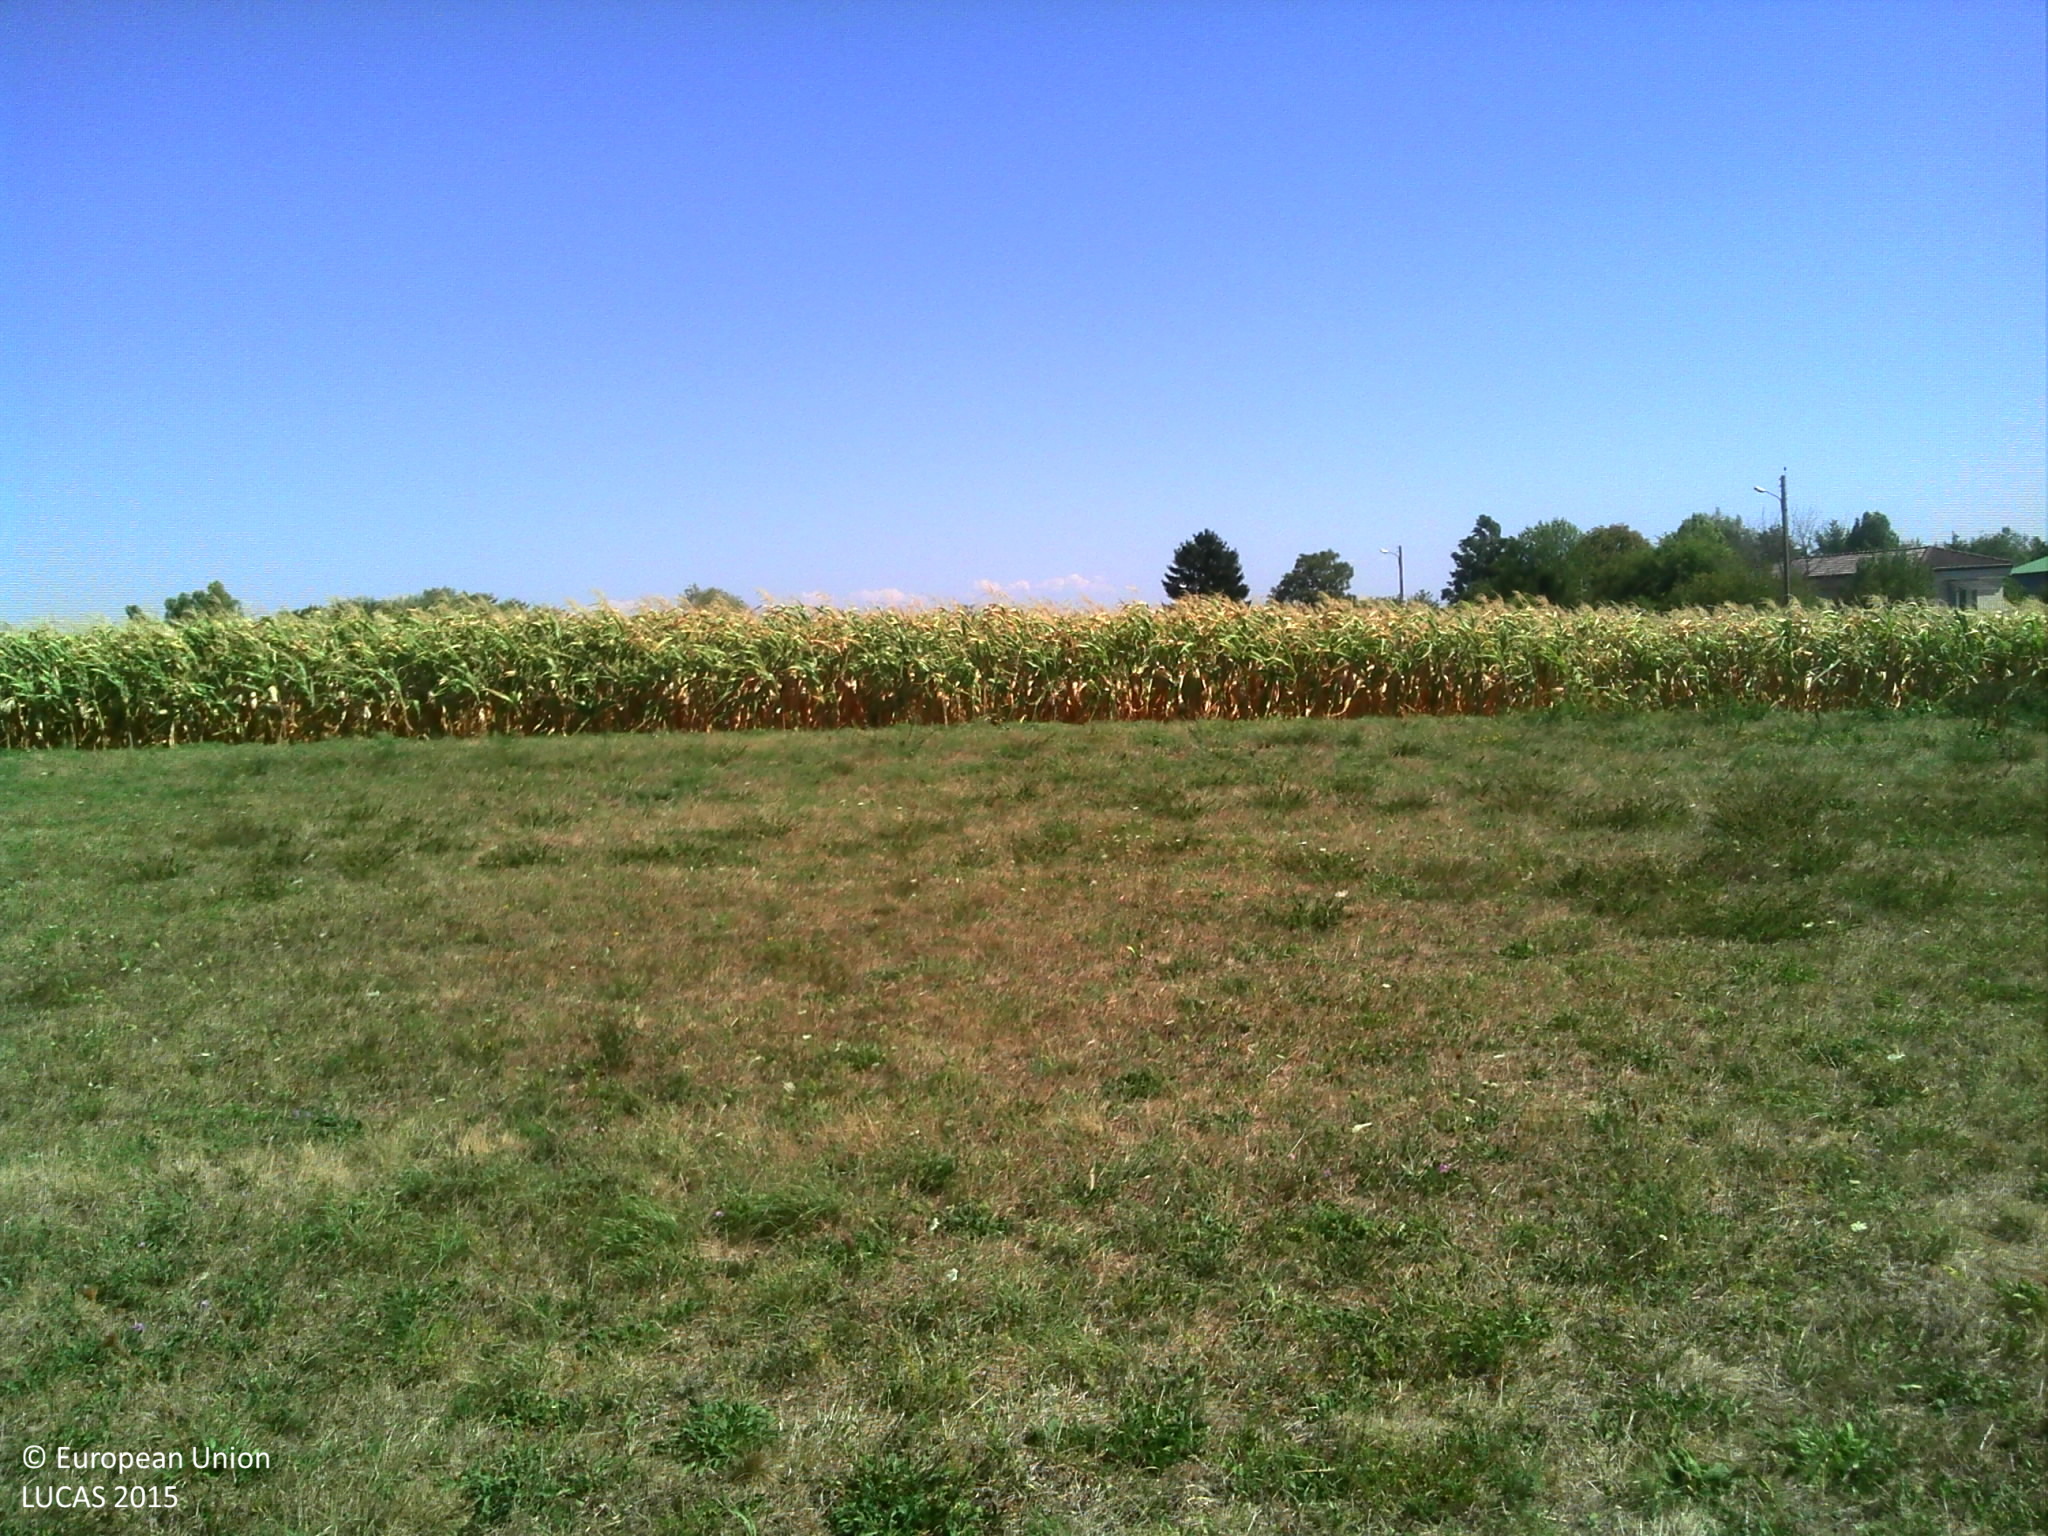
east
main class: Grassland
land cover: Grassland without tree/shrub cover
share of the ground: > 75 %
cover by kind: herbaceous plants 100 %
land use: Air transport
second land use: Agriculture (excluding fallow land and kitchen gardens)
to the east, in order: Grassland without tree/shrub cover; Maize; Grass margins; Paved roads, cycling and walking lanes; Grass margins; Soya; Grass margins; Paved roads, cycling and walking lanes; Grass margins; Maize; Artificial constructions in urban areas
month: August
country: FR
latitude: 46.2968
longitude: 4.7965
